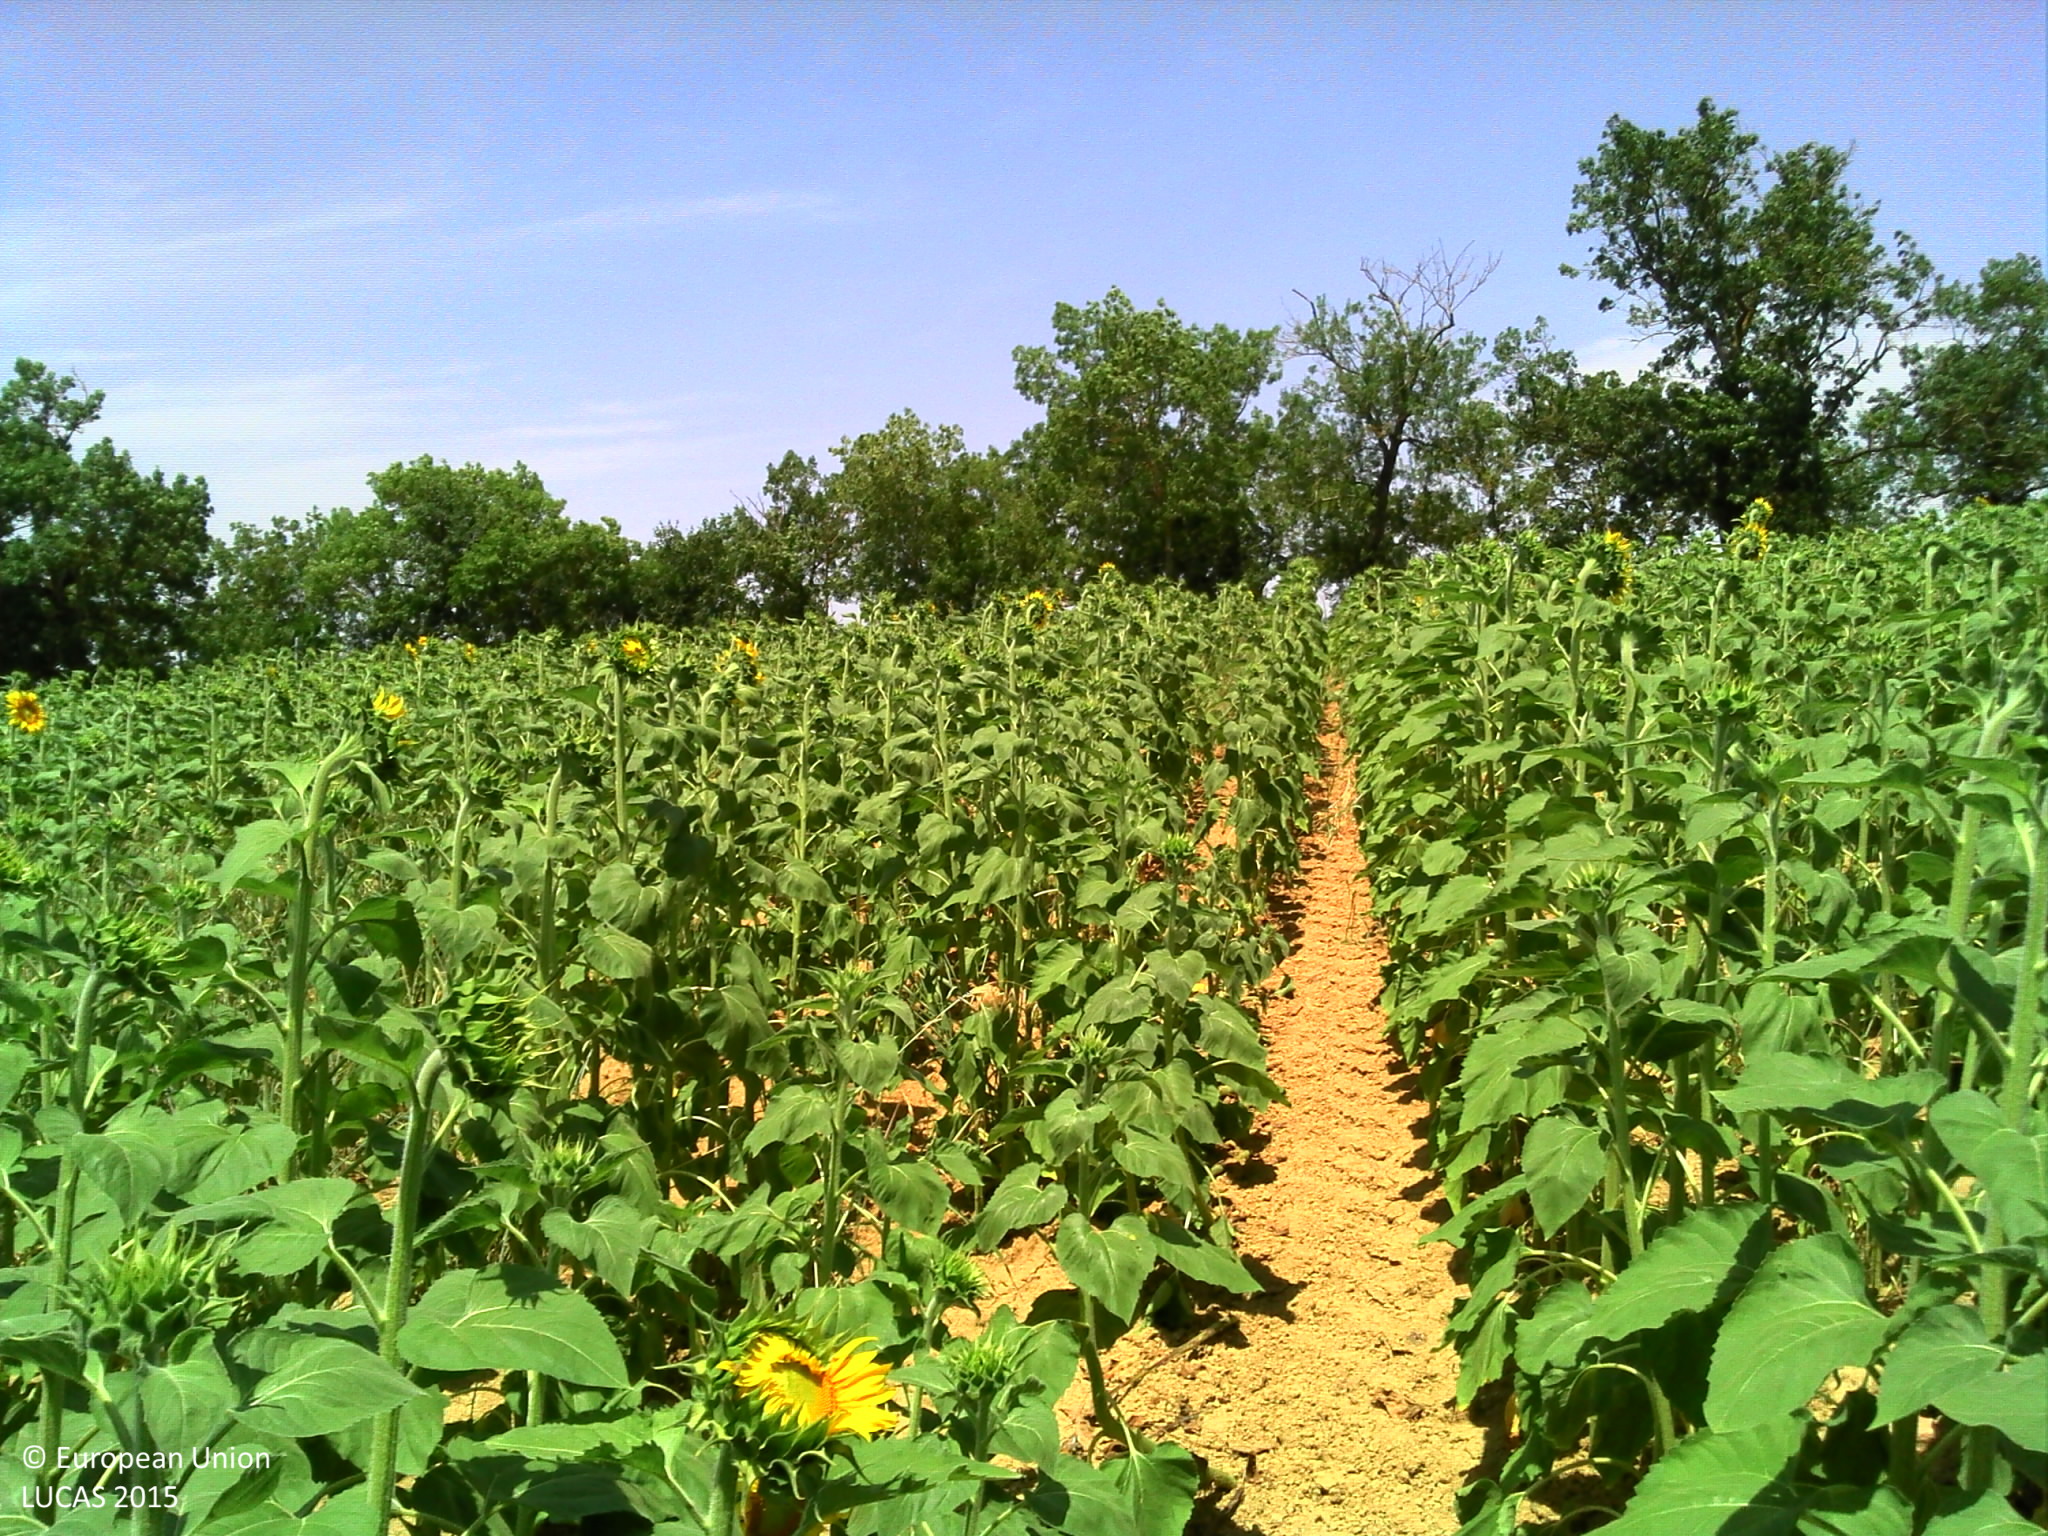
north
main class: Cropland
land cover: Sunflower
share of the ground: > 75 %
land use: Agriculture (excluding fallow land and kitchen gardens)
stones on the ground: < 10 %
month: July
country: FR
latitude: 43.4881
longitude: 1.0117
